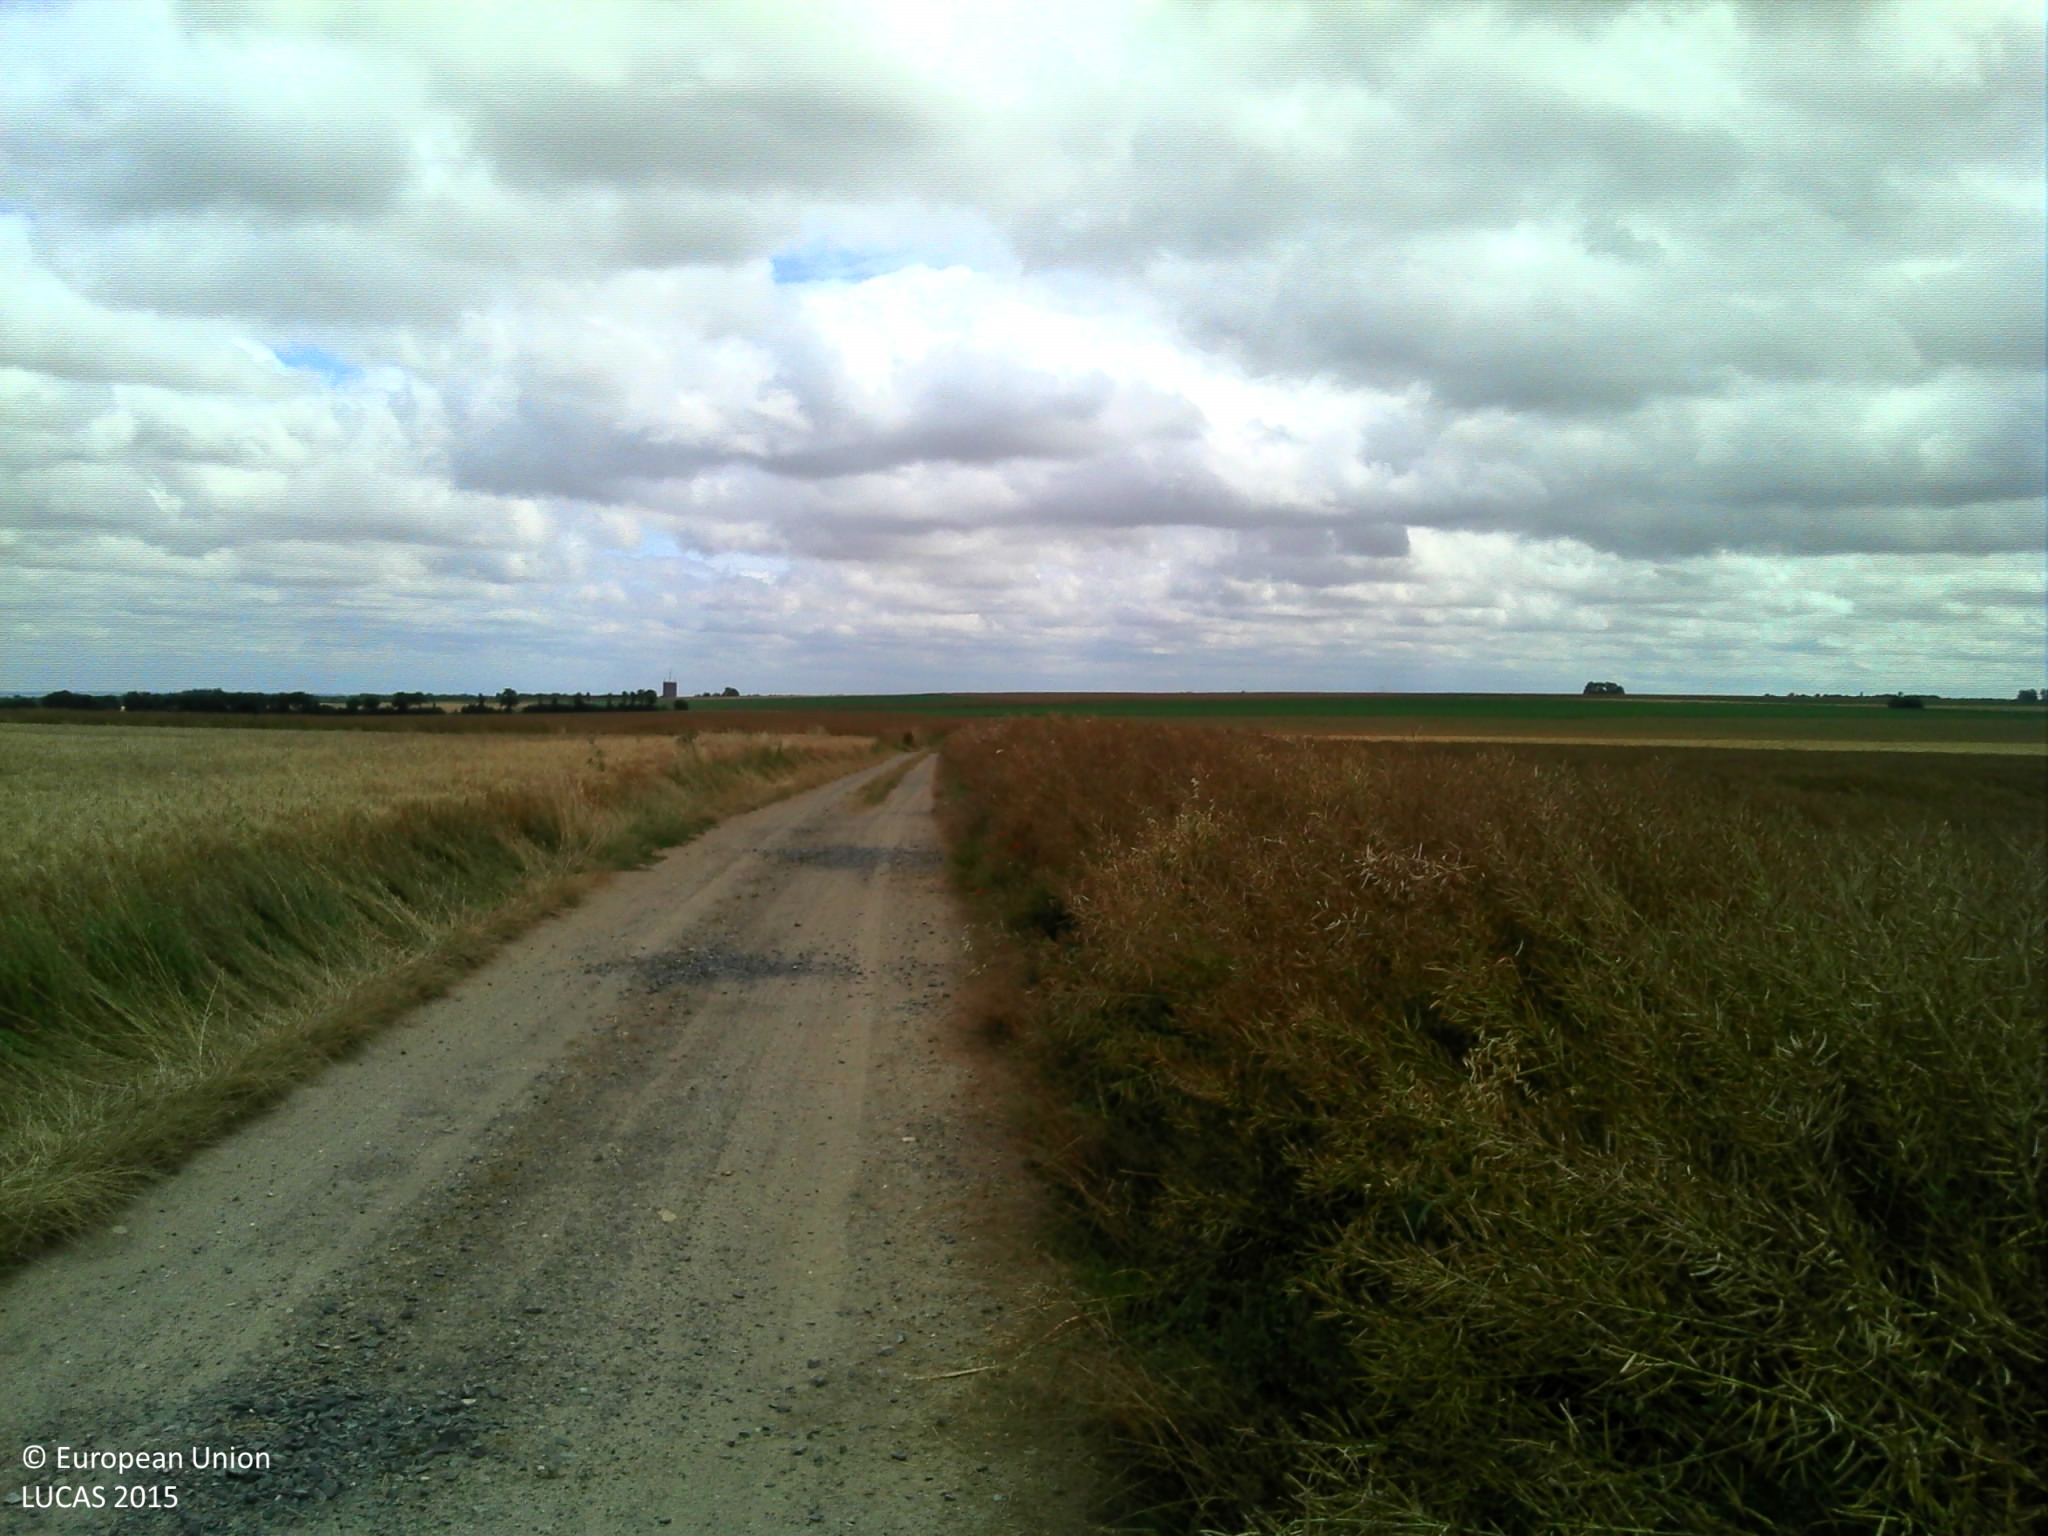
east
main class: Cropland
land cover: Rape and turnip rape
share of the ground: > 75 %
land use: Agriculture (excluding fallow land and kitchen gardens)
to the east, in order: Rape and turnip rape; Oats
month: July
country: FR
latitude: 48.9915
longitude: -0.2974
